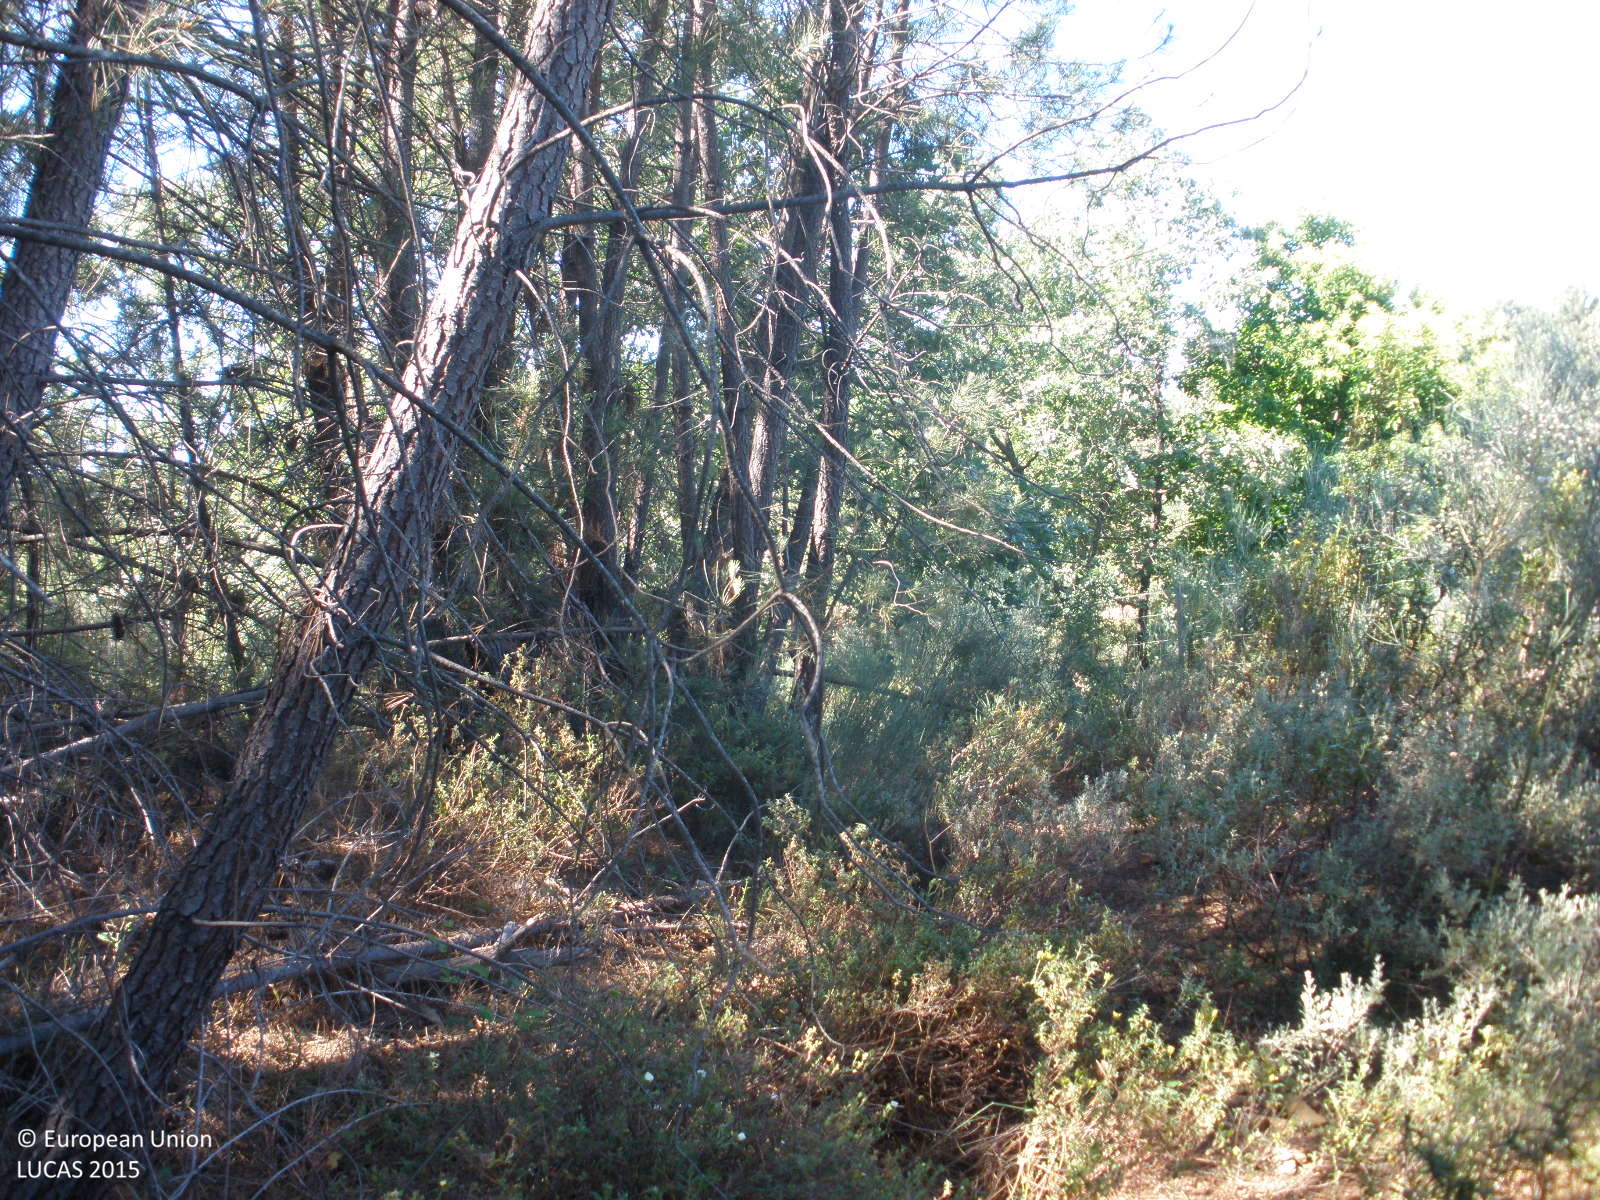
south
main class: Woodland
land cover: Pine dominated coniferous woodland
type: coniferous forest of the mediterranean region
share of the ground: > 75 %
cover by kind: coniferous forest trees 90 %, shrubs 10 %
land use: Forestry
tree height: > 5 m
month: May
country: ES
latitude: 40.2106
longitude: -6.5688
